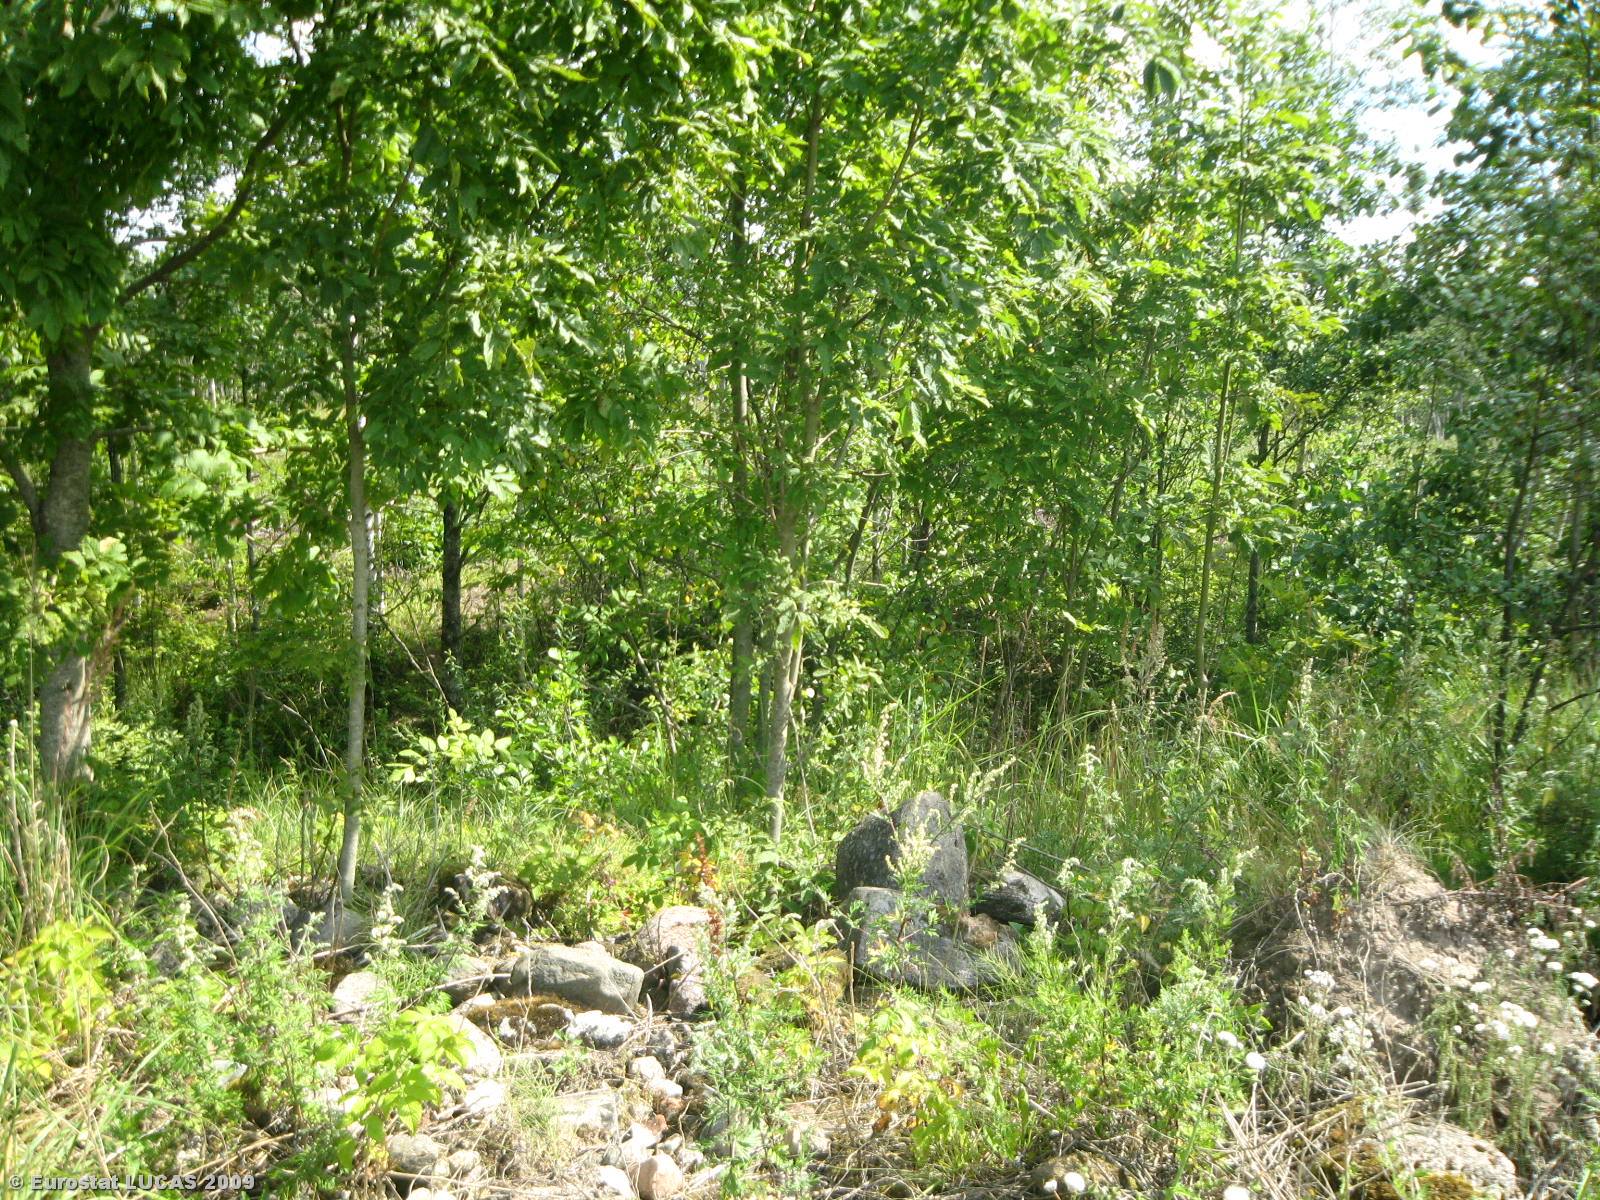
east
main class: Grassland
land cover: Spontaneously vegetated surfaces
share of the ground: > 75 %
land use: Fallow land
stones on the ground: < 10 %
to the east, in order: Spontaneously vegetated surfaces; Broadleaved woodland; Ditches and canals; Broadleaved woodland
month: August
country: LT
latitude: 55.1780
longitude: 23.6662
